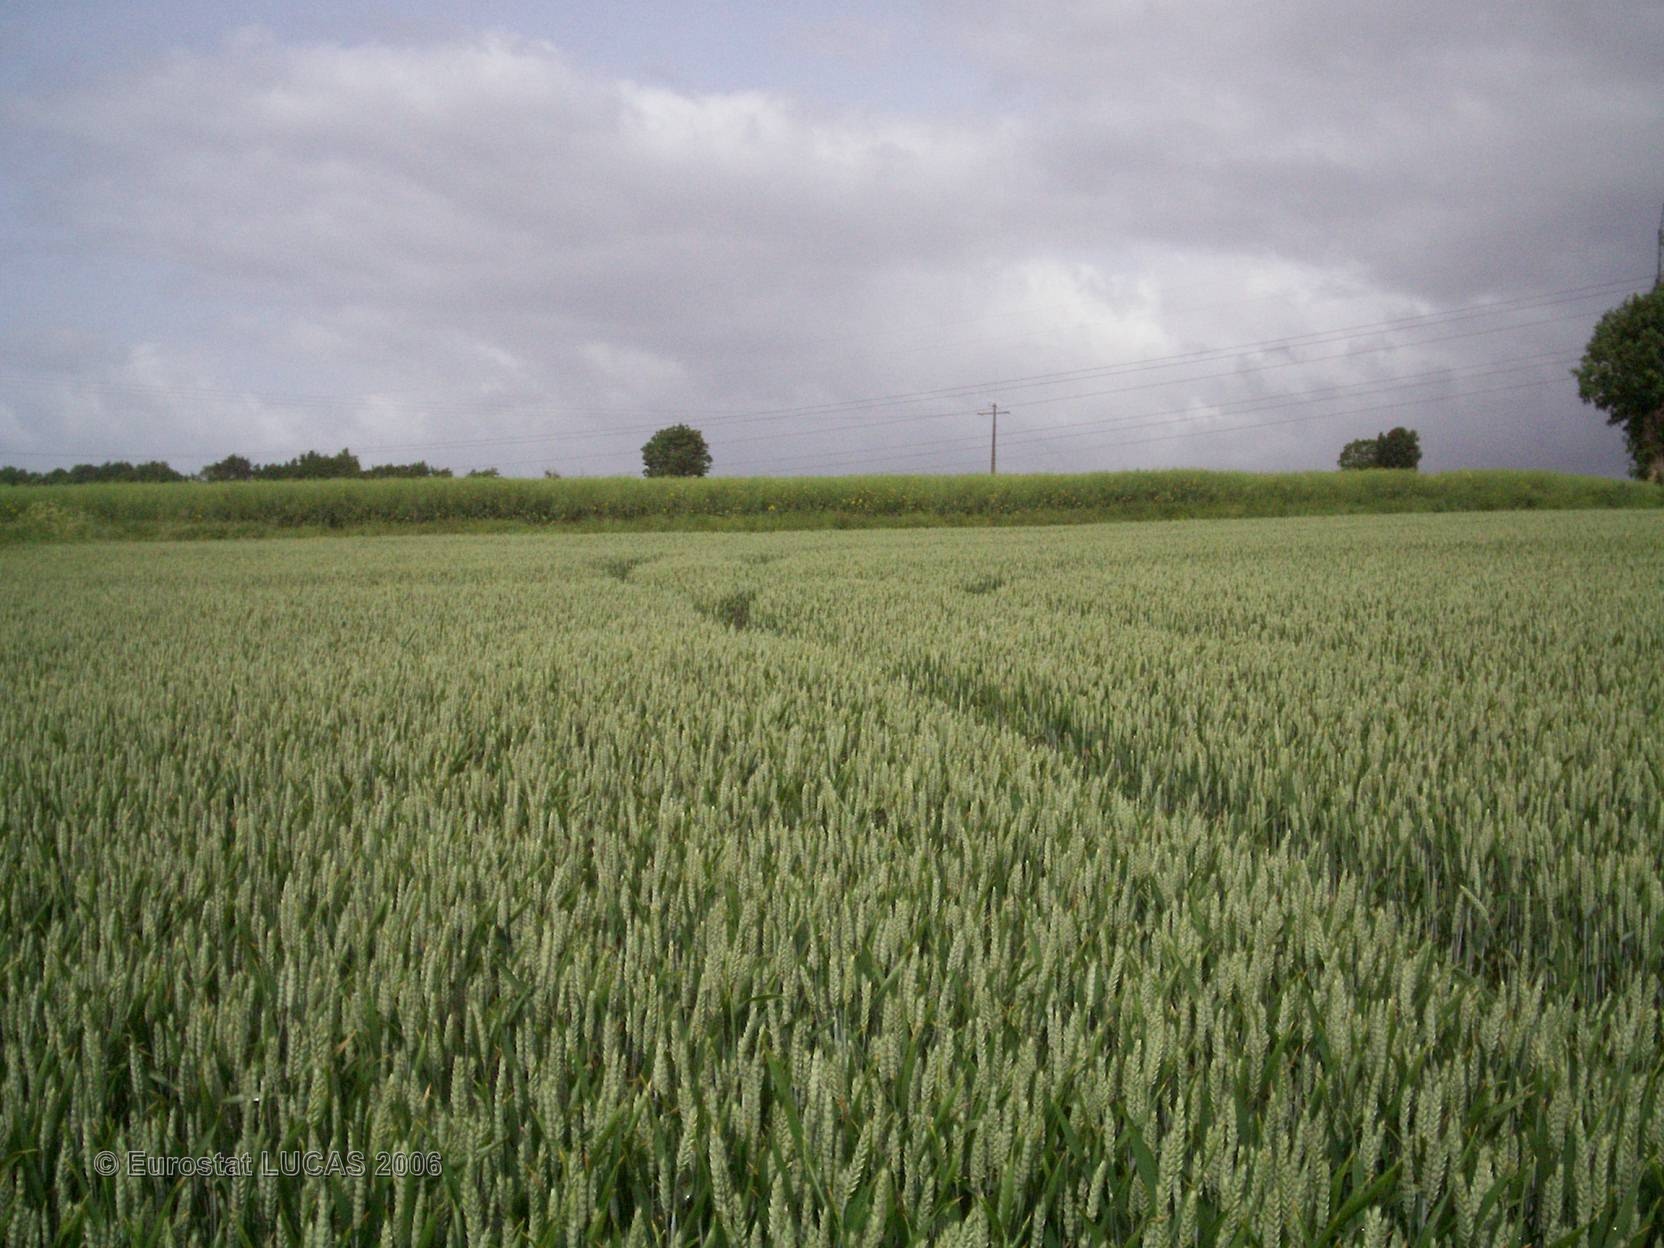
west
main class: Cropland
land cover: Common wheat
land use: Agriculture (excluding fallow land and kitchen gardens)
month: May
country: FR
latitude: 46.4391
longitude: -0.2411
